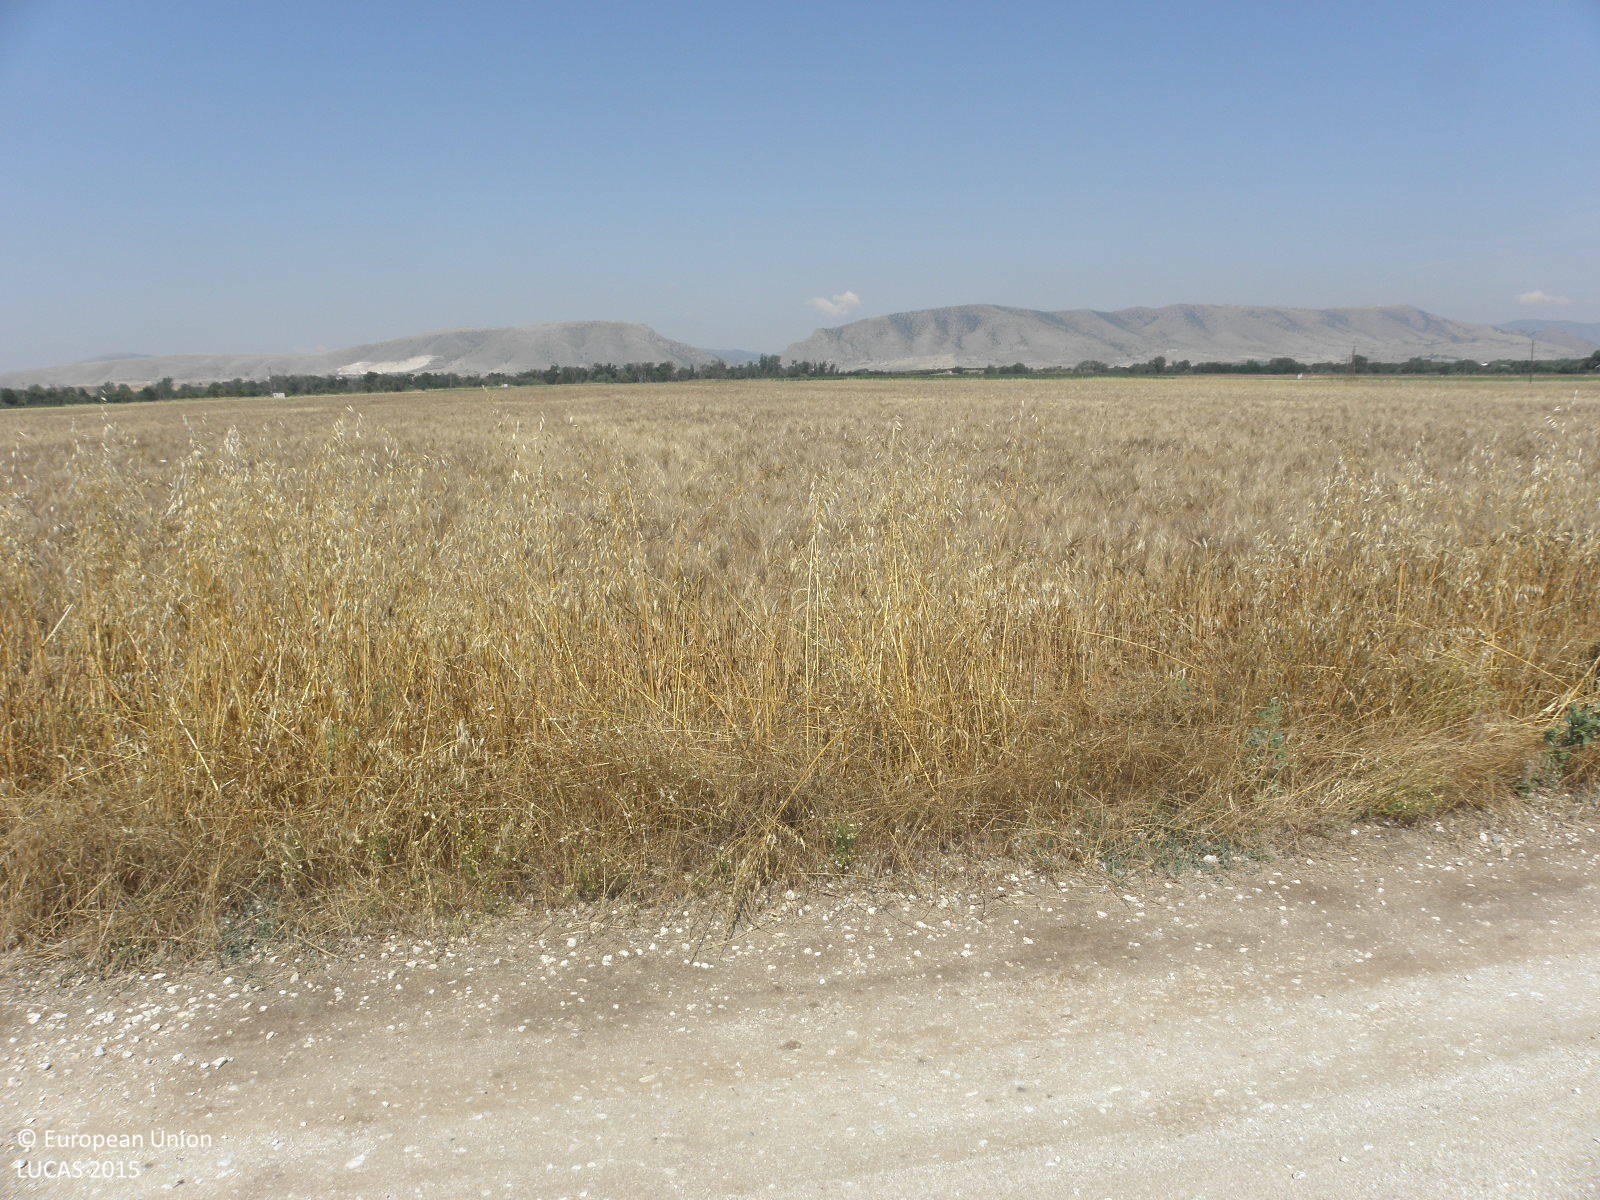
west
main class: Cropland
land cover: Durum wheat
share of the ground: > 75 %
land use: Agriculture (excluding fallow land and kitchen gardens)
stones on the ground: < 10 %
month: June
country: GR
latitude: 39.6508
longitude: 22.3309
